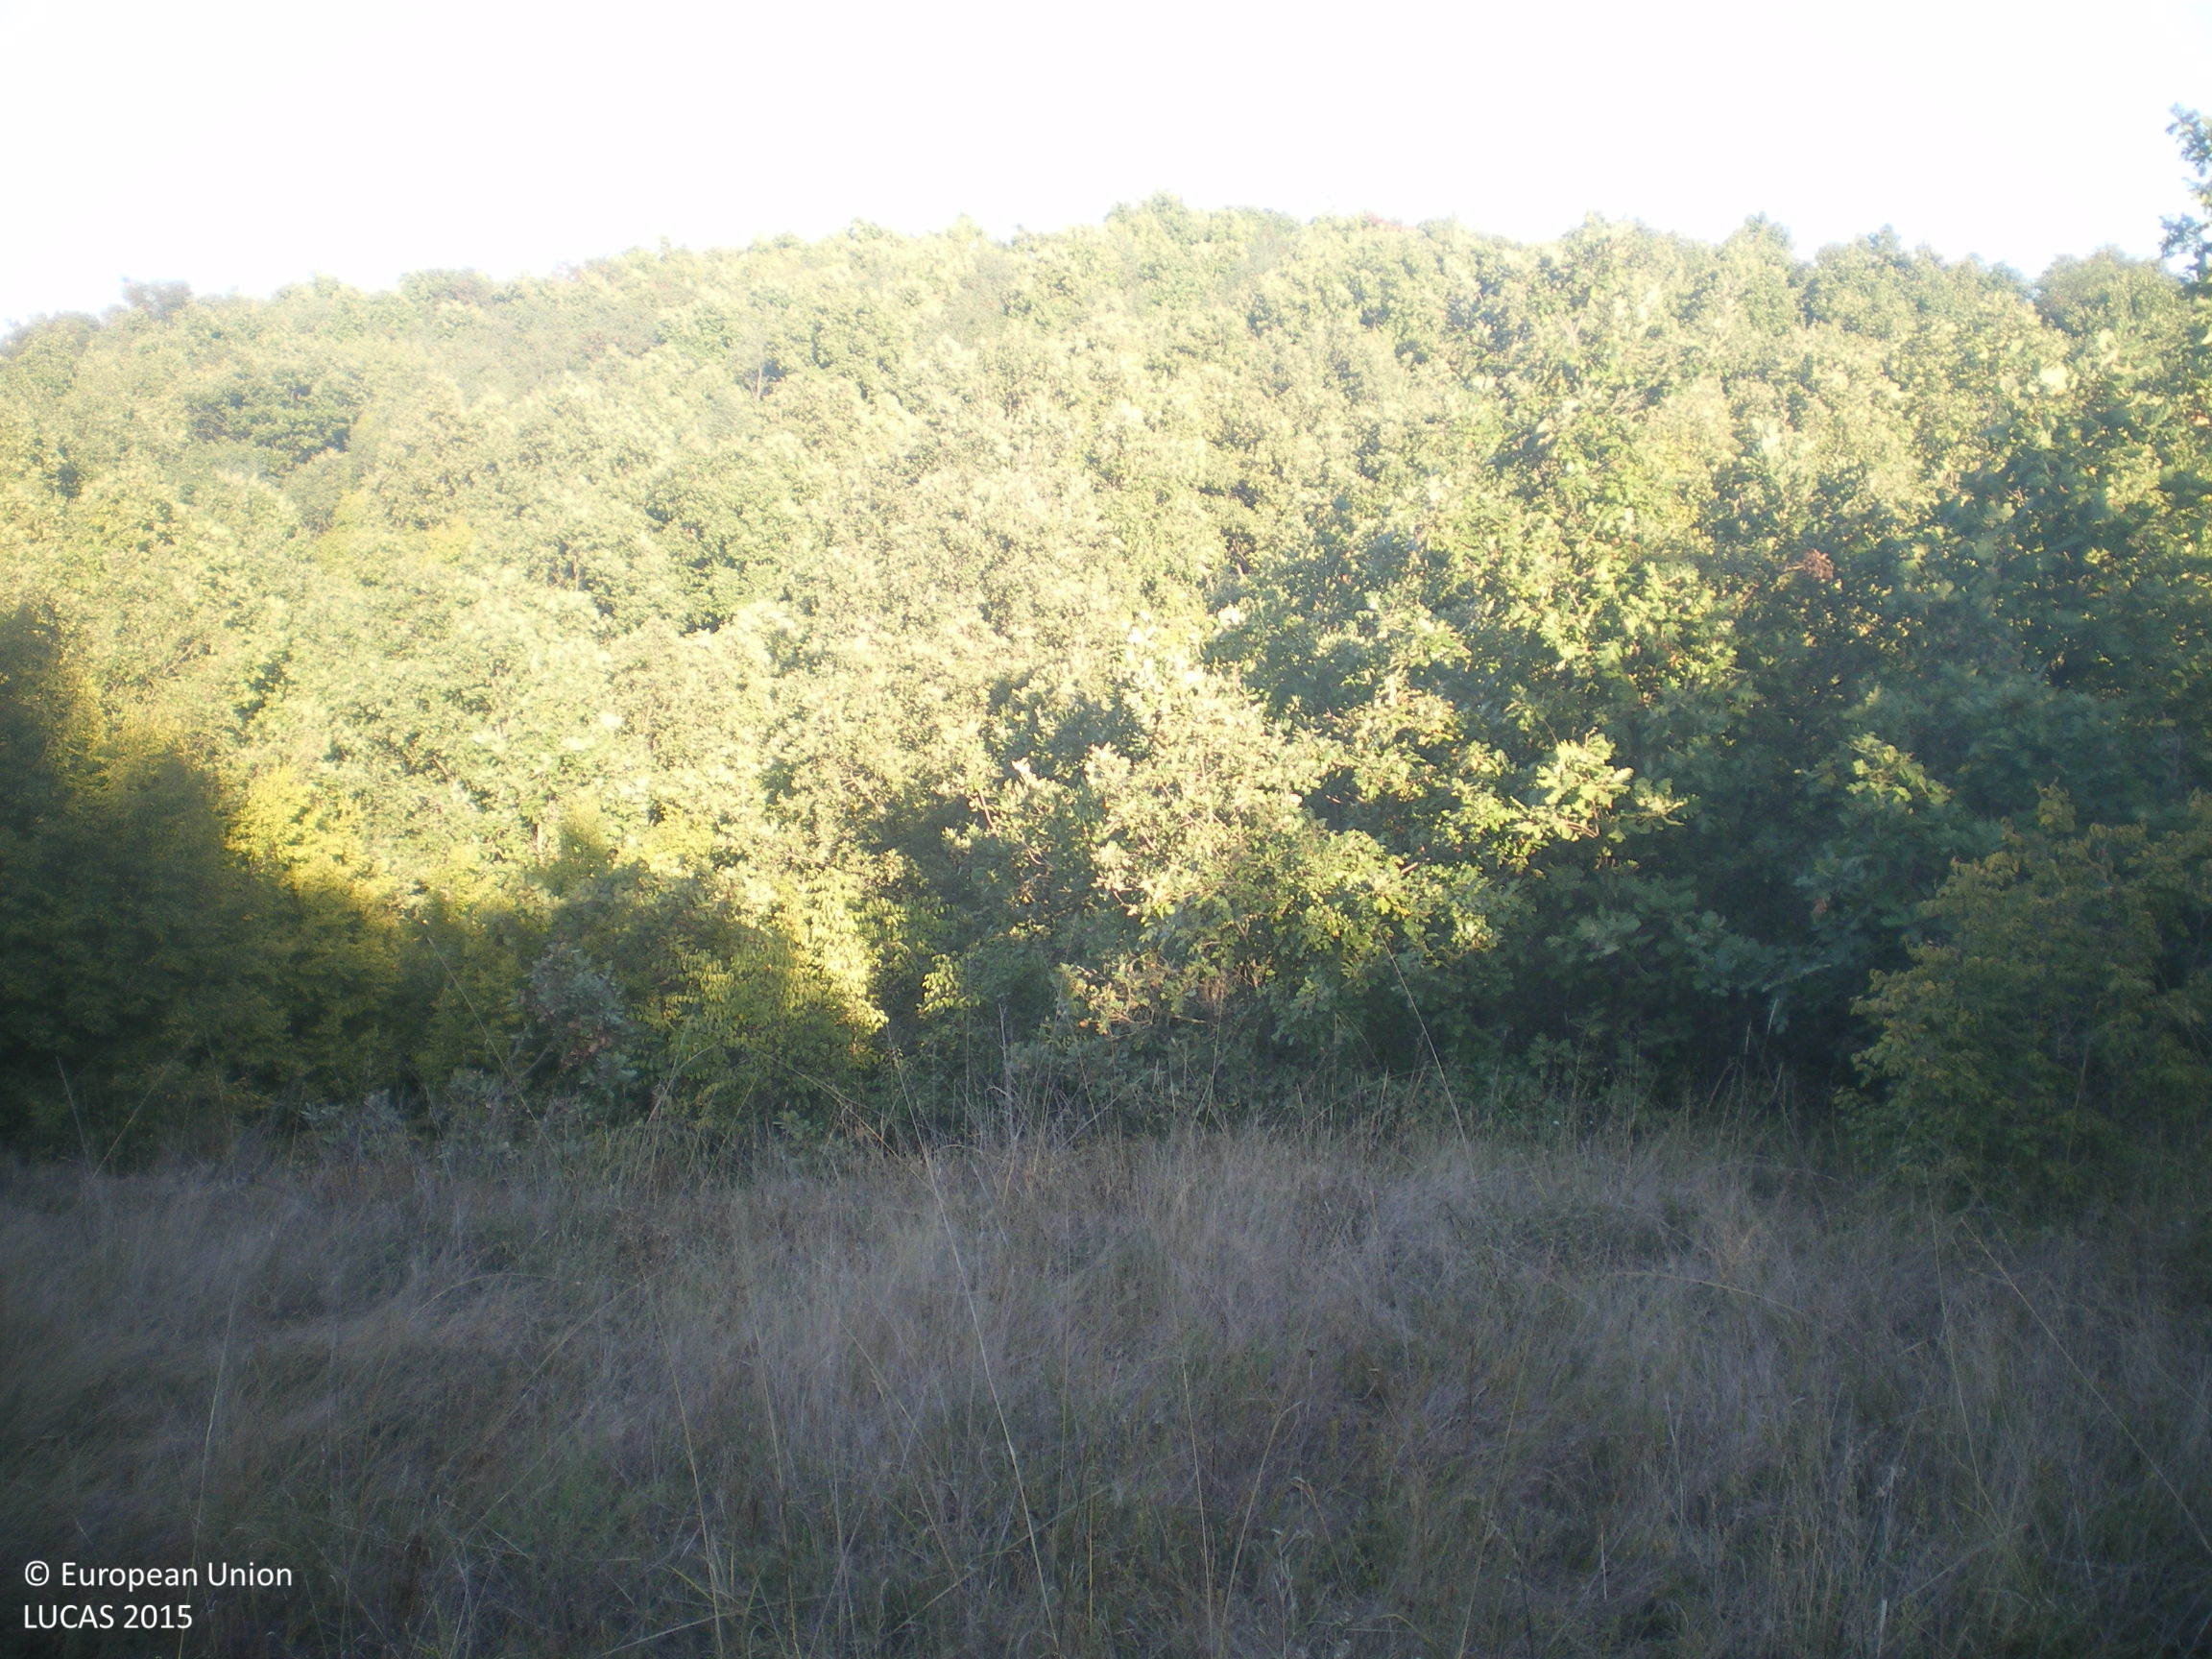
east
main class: Woodland
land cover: Broadleaved woodland
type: mesophytic deciduous forest
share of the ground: 50 - 75 %
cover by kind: broadleaved forest trees 75 %, herbaceous plants 20 %, shrubs 5 %
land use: Forestry
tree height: > 5 m
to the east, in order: Broadleaved woodland; Grassland with sparse tree/shrub cover; Broadleaved woodland; Ditches and canals; Broadleaved woodland; Tracks; Broadleaved woodland; Ditches and canals; Broadleaved woodland
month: September
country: BG
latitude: 41.8529
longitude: 25.9837
